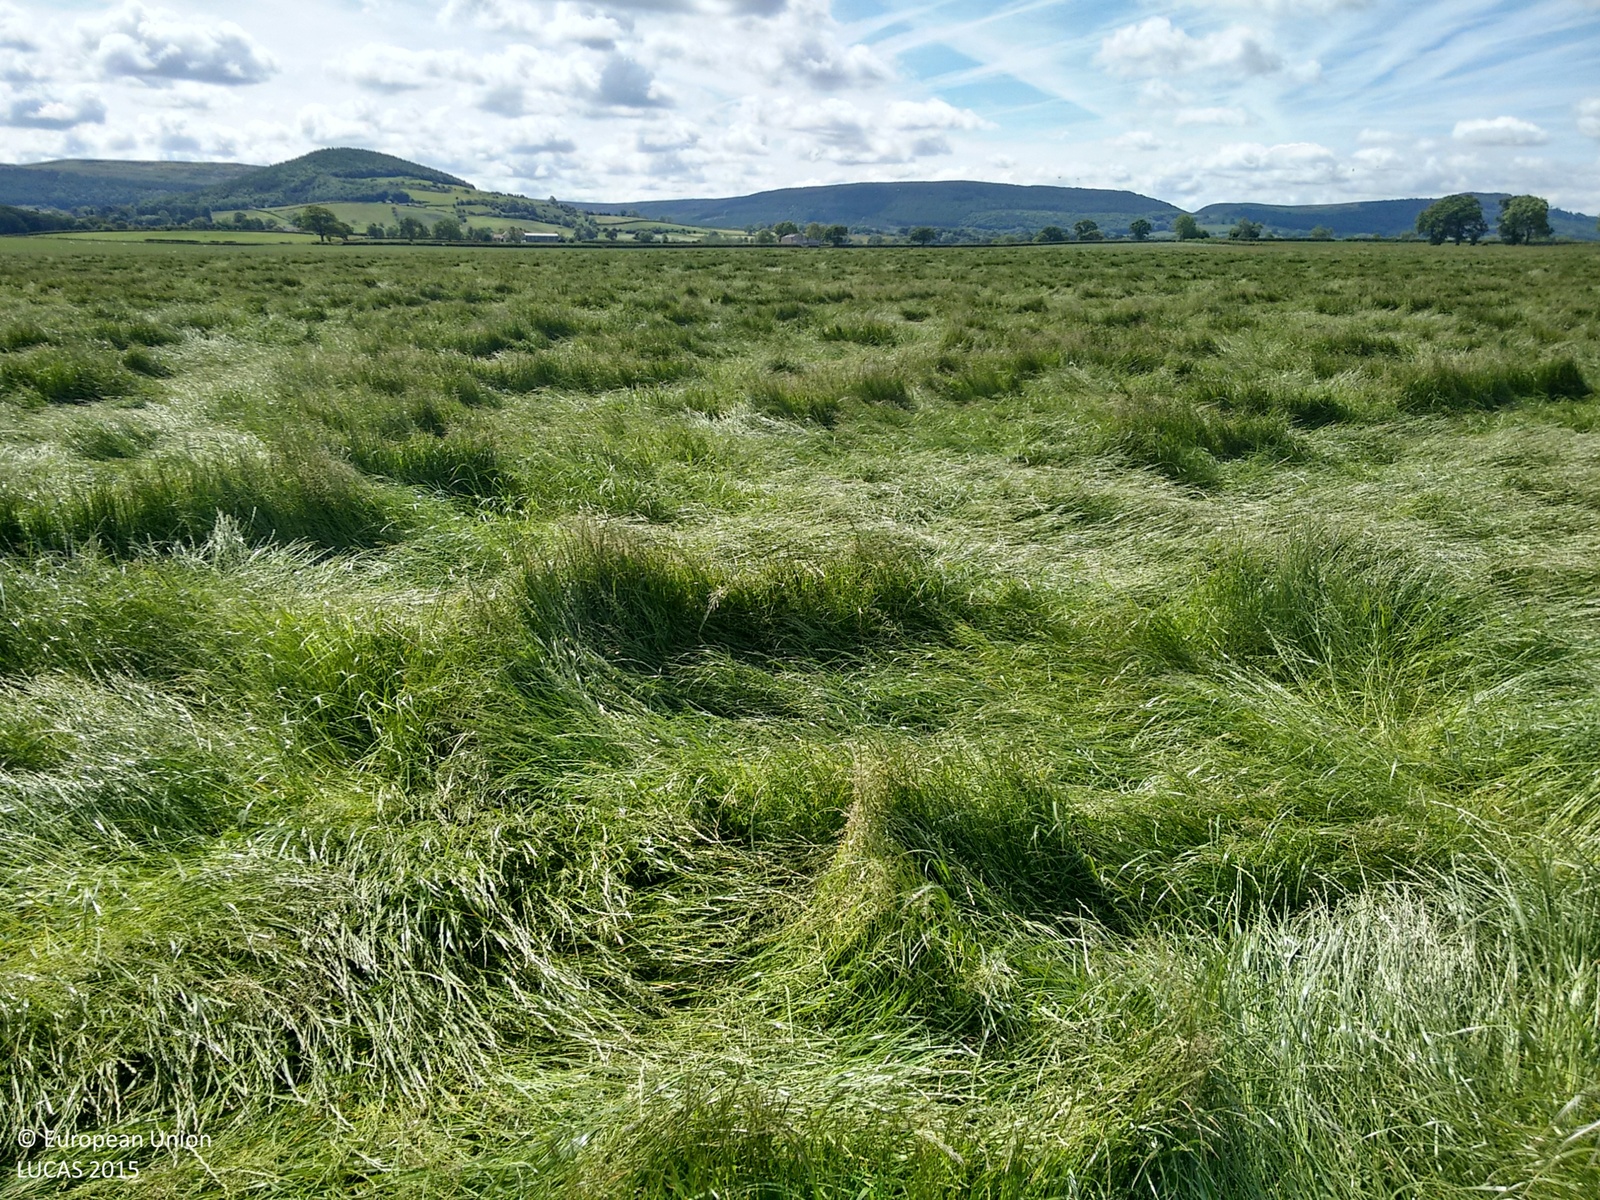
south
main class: Grassland
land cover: Grassland without tree/shrub cover
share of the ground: > 75 %
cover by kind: herbaceous plants 100 %
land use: Agriculture (excluding fallow land and kitchen gardens)
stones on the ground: < 10 %
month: June
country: GB
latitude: 54.4374
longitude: -1.2539
